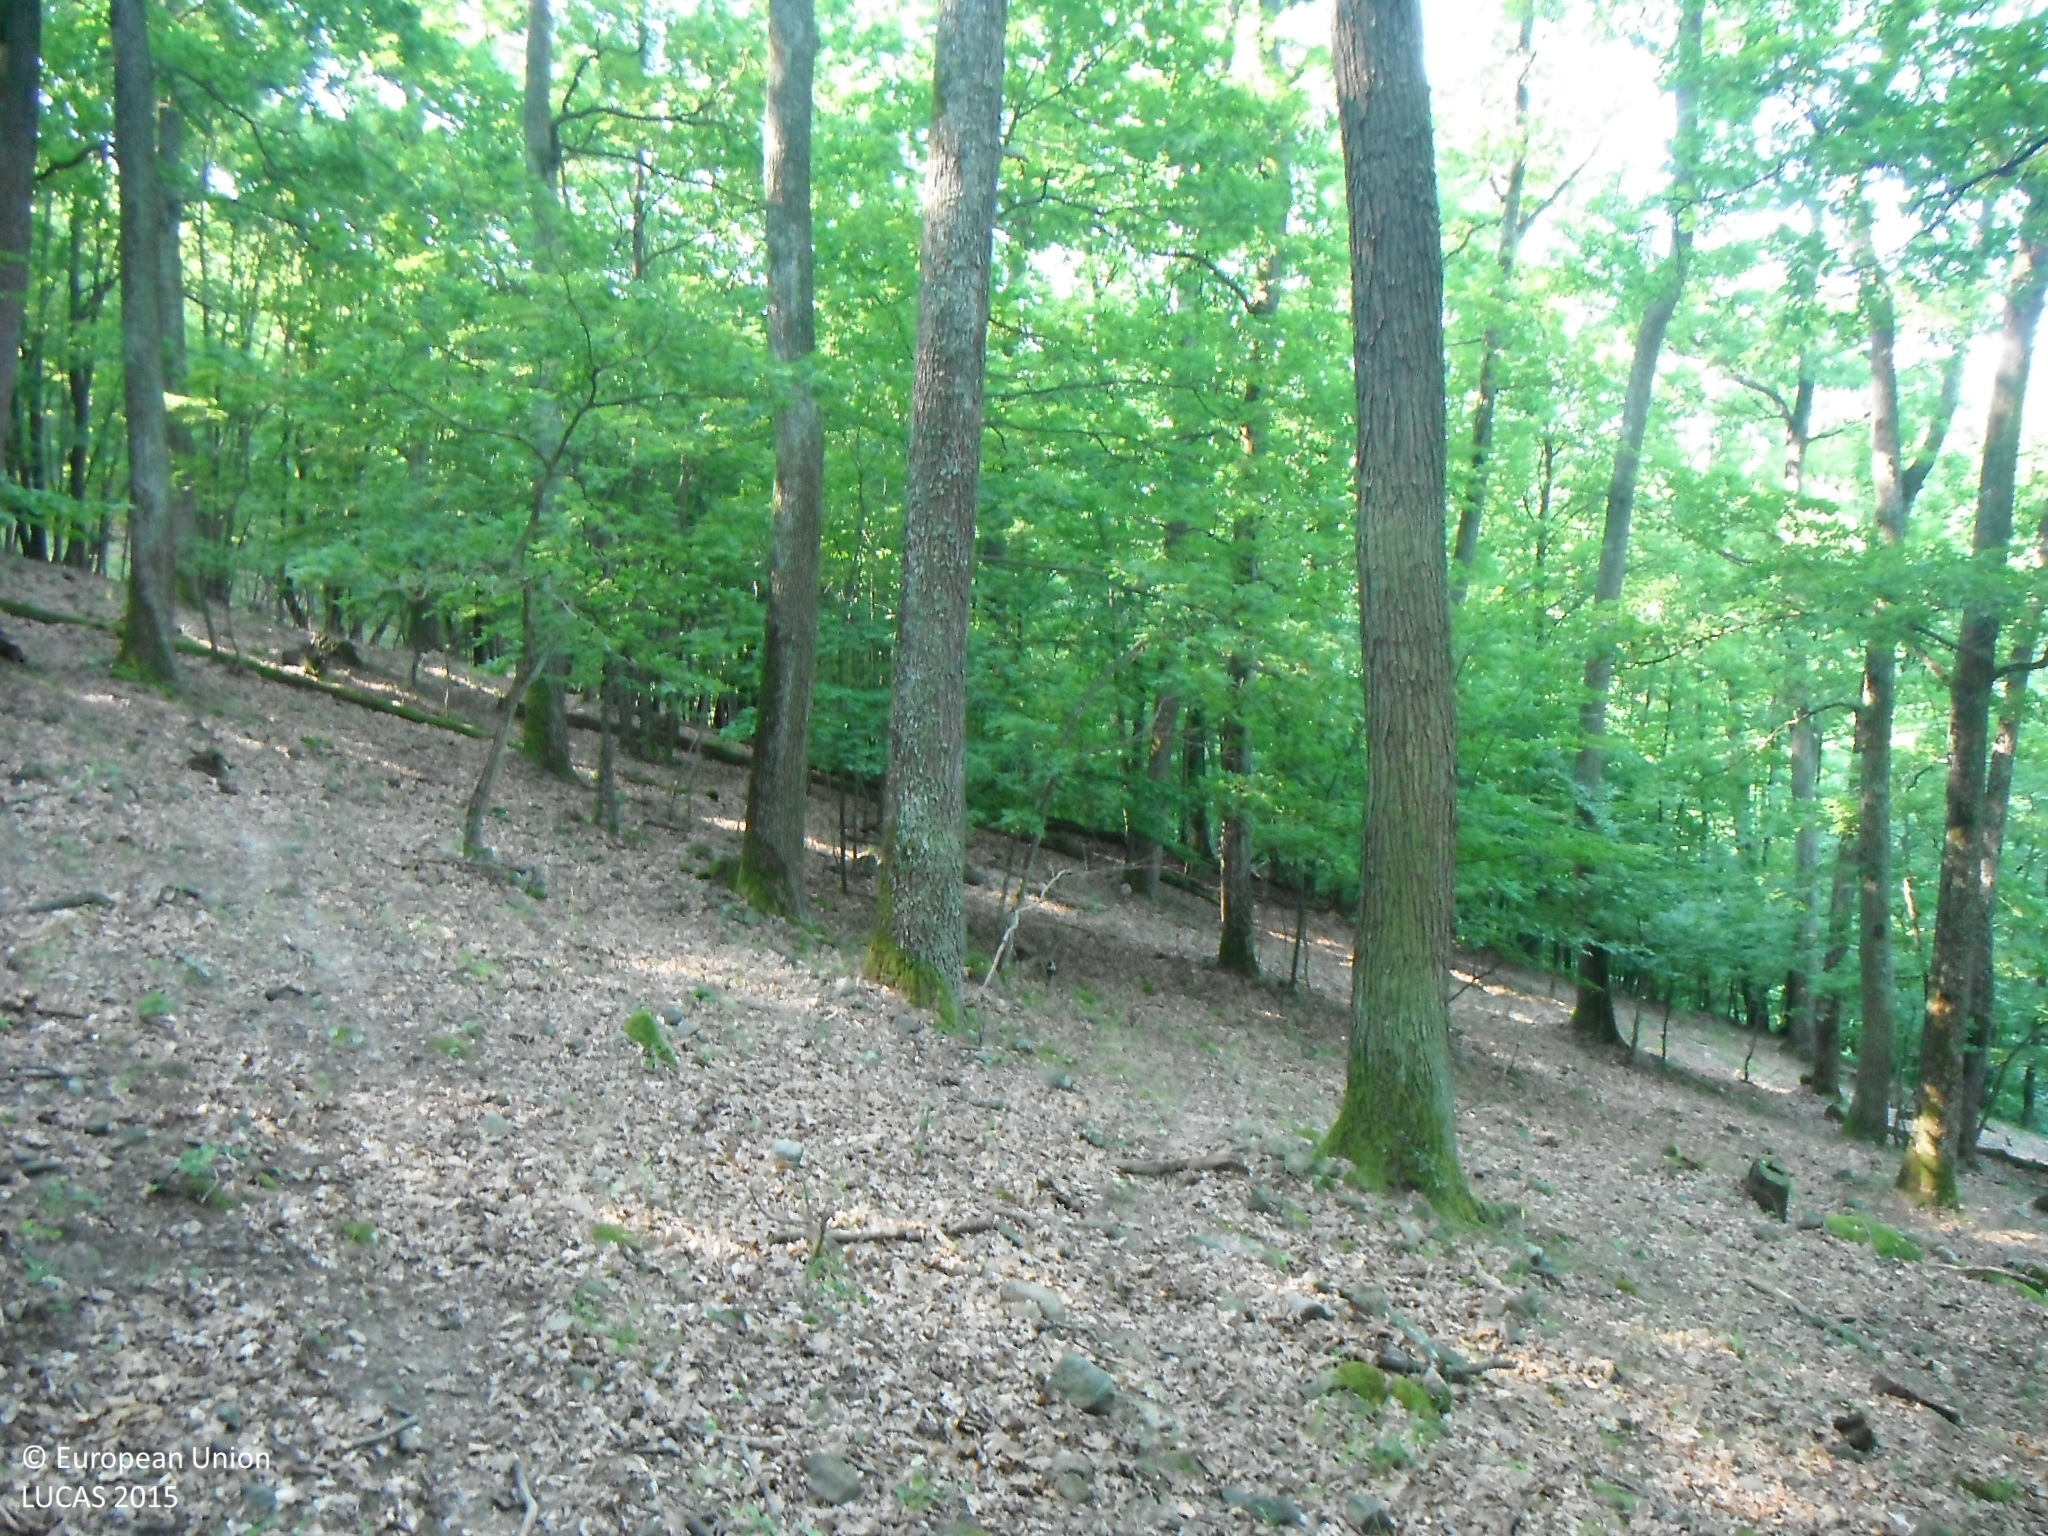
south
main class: Woodland
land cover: Broadleaved woodland
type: acidophilous oak and oak-birch forest
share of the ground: > 75 %
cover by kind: broadleaved forest trees 95 %, herbaceous plants 5 %
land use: Forestry
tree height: > 5 m
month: July
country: SK
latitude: 48.1994
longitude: 19.2109
